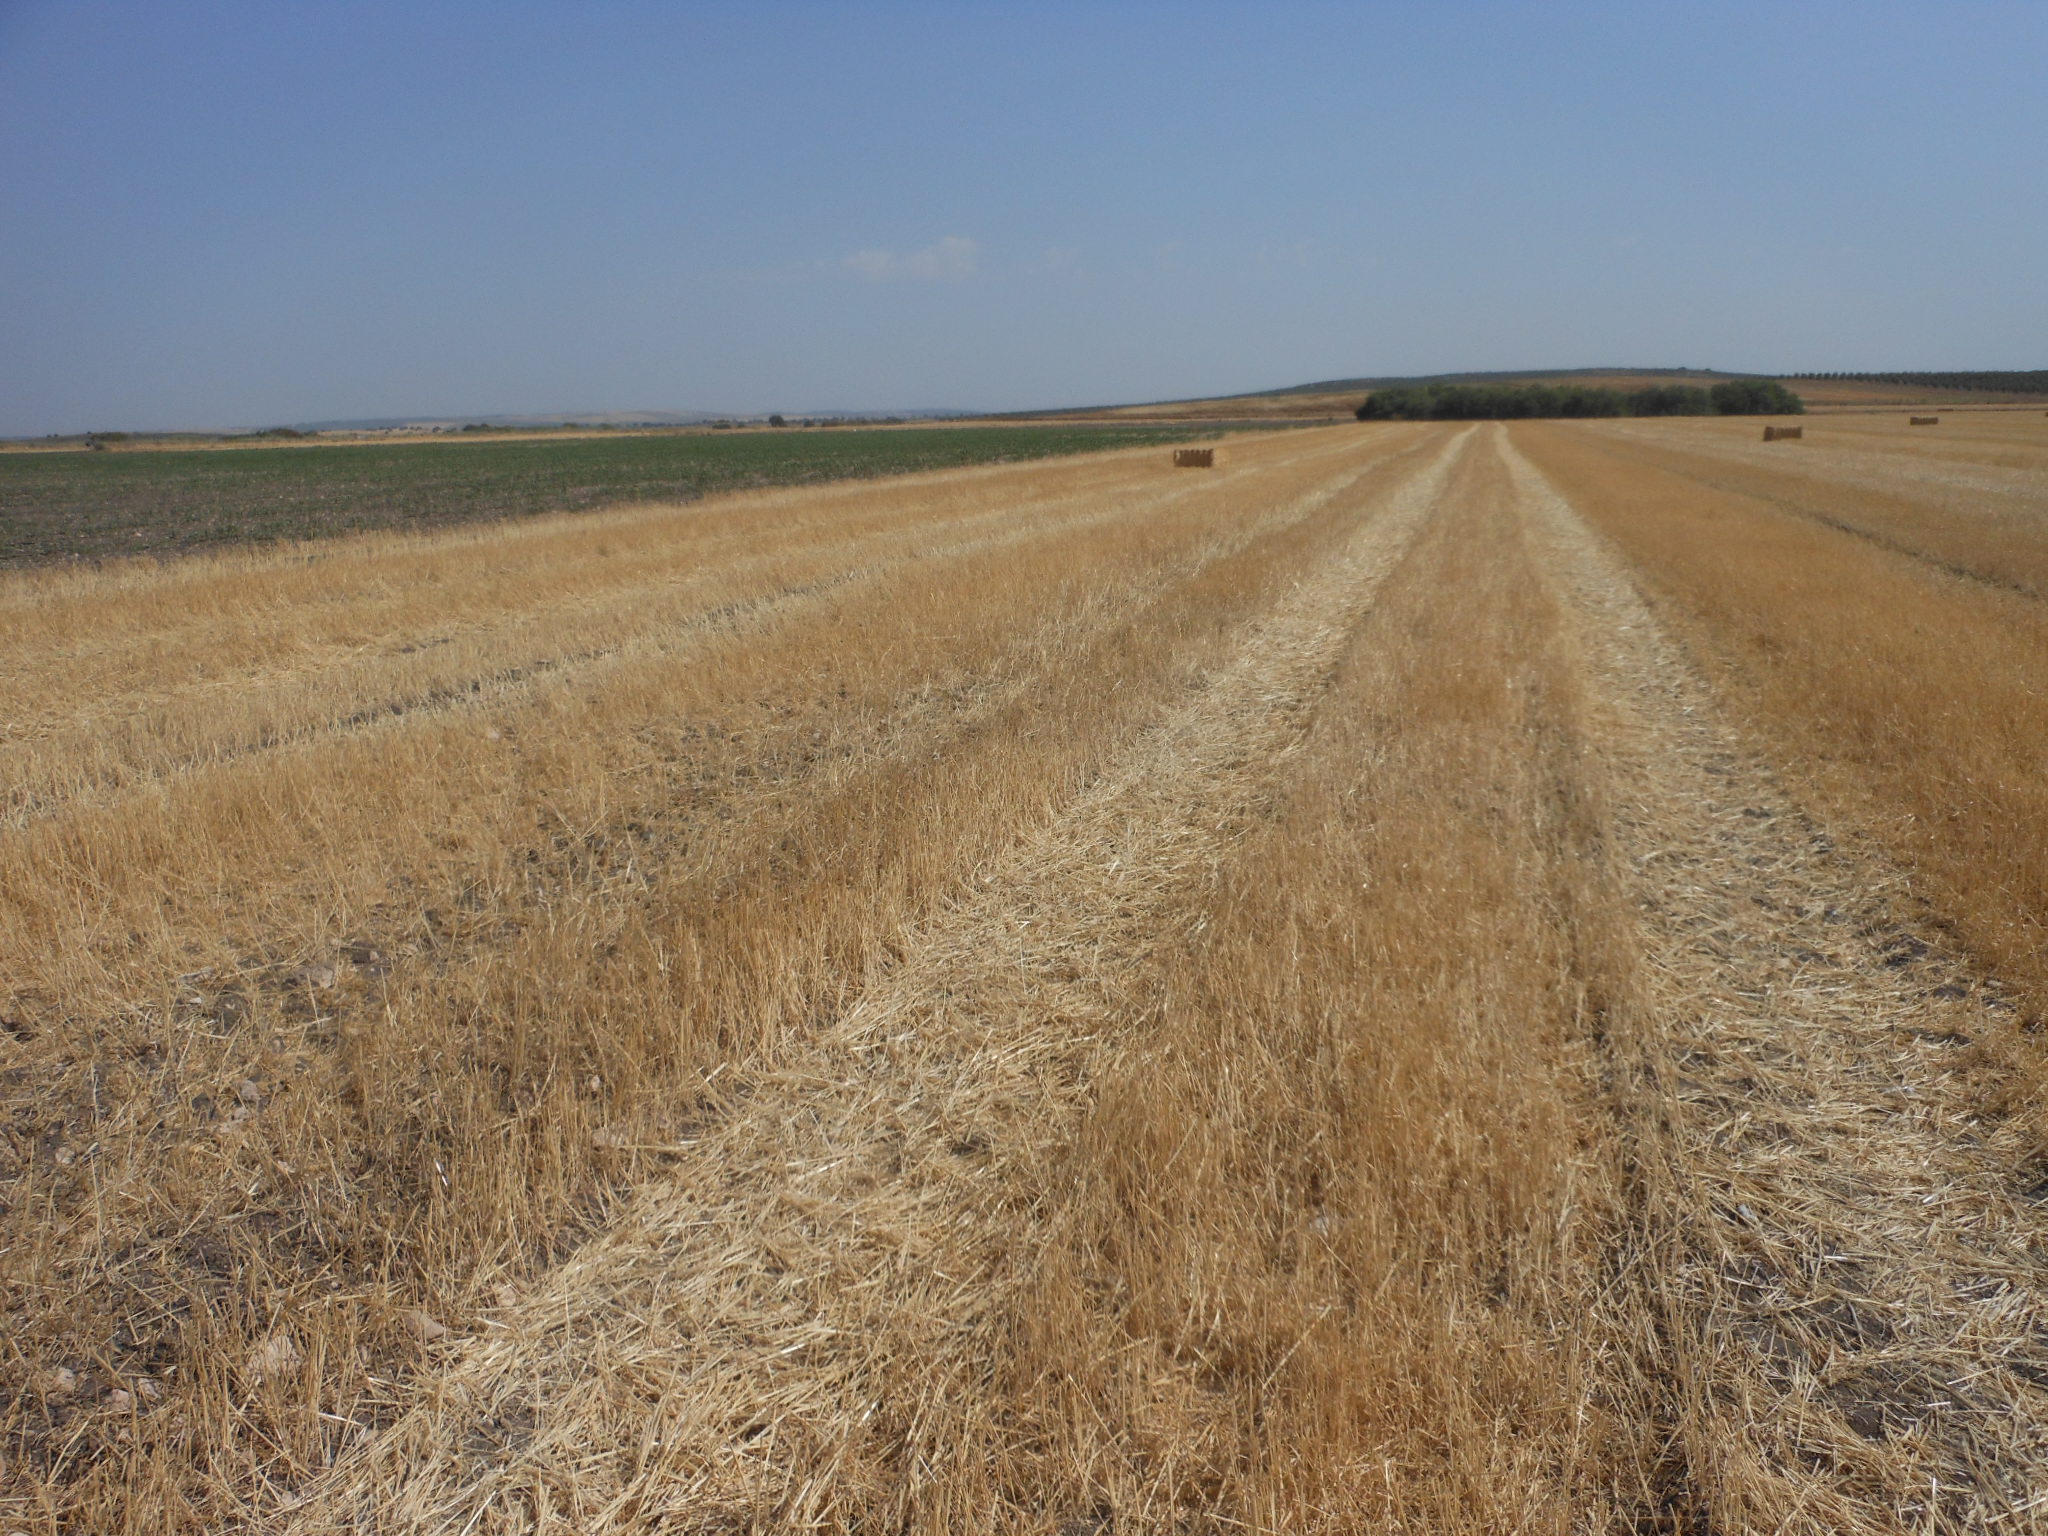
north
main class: Cropland
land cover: Common wheat
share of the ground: < 10 %
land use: Agriculture (excluding fallow land and kitchen gardens)
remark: Harvested field
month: June
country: ES
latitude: 37.3226
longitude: -5.1197
